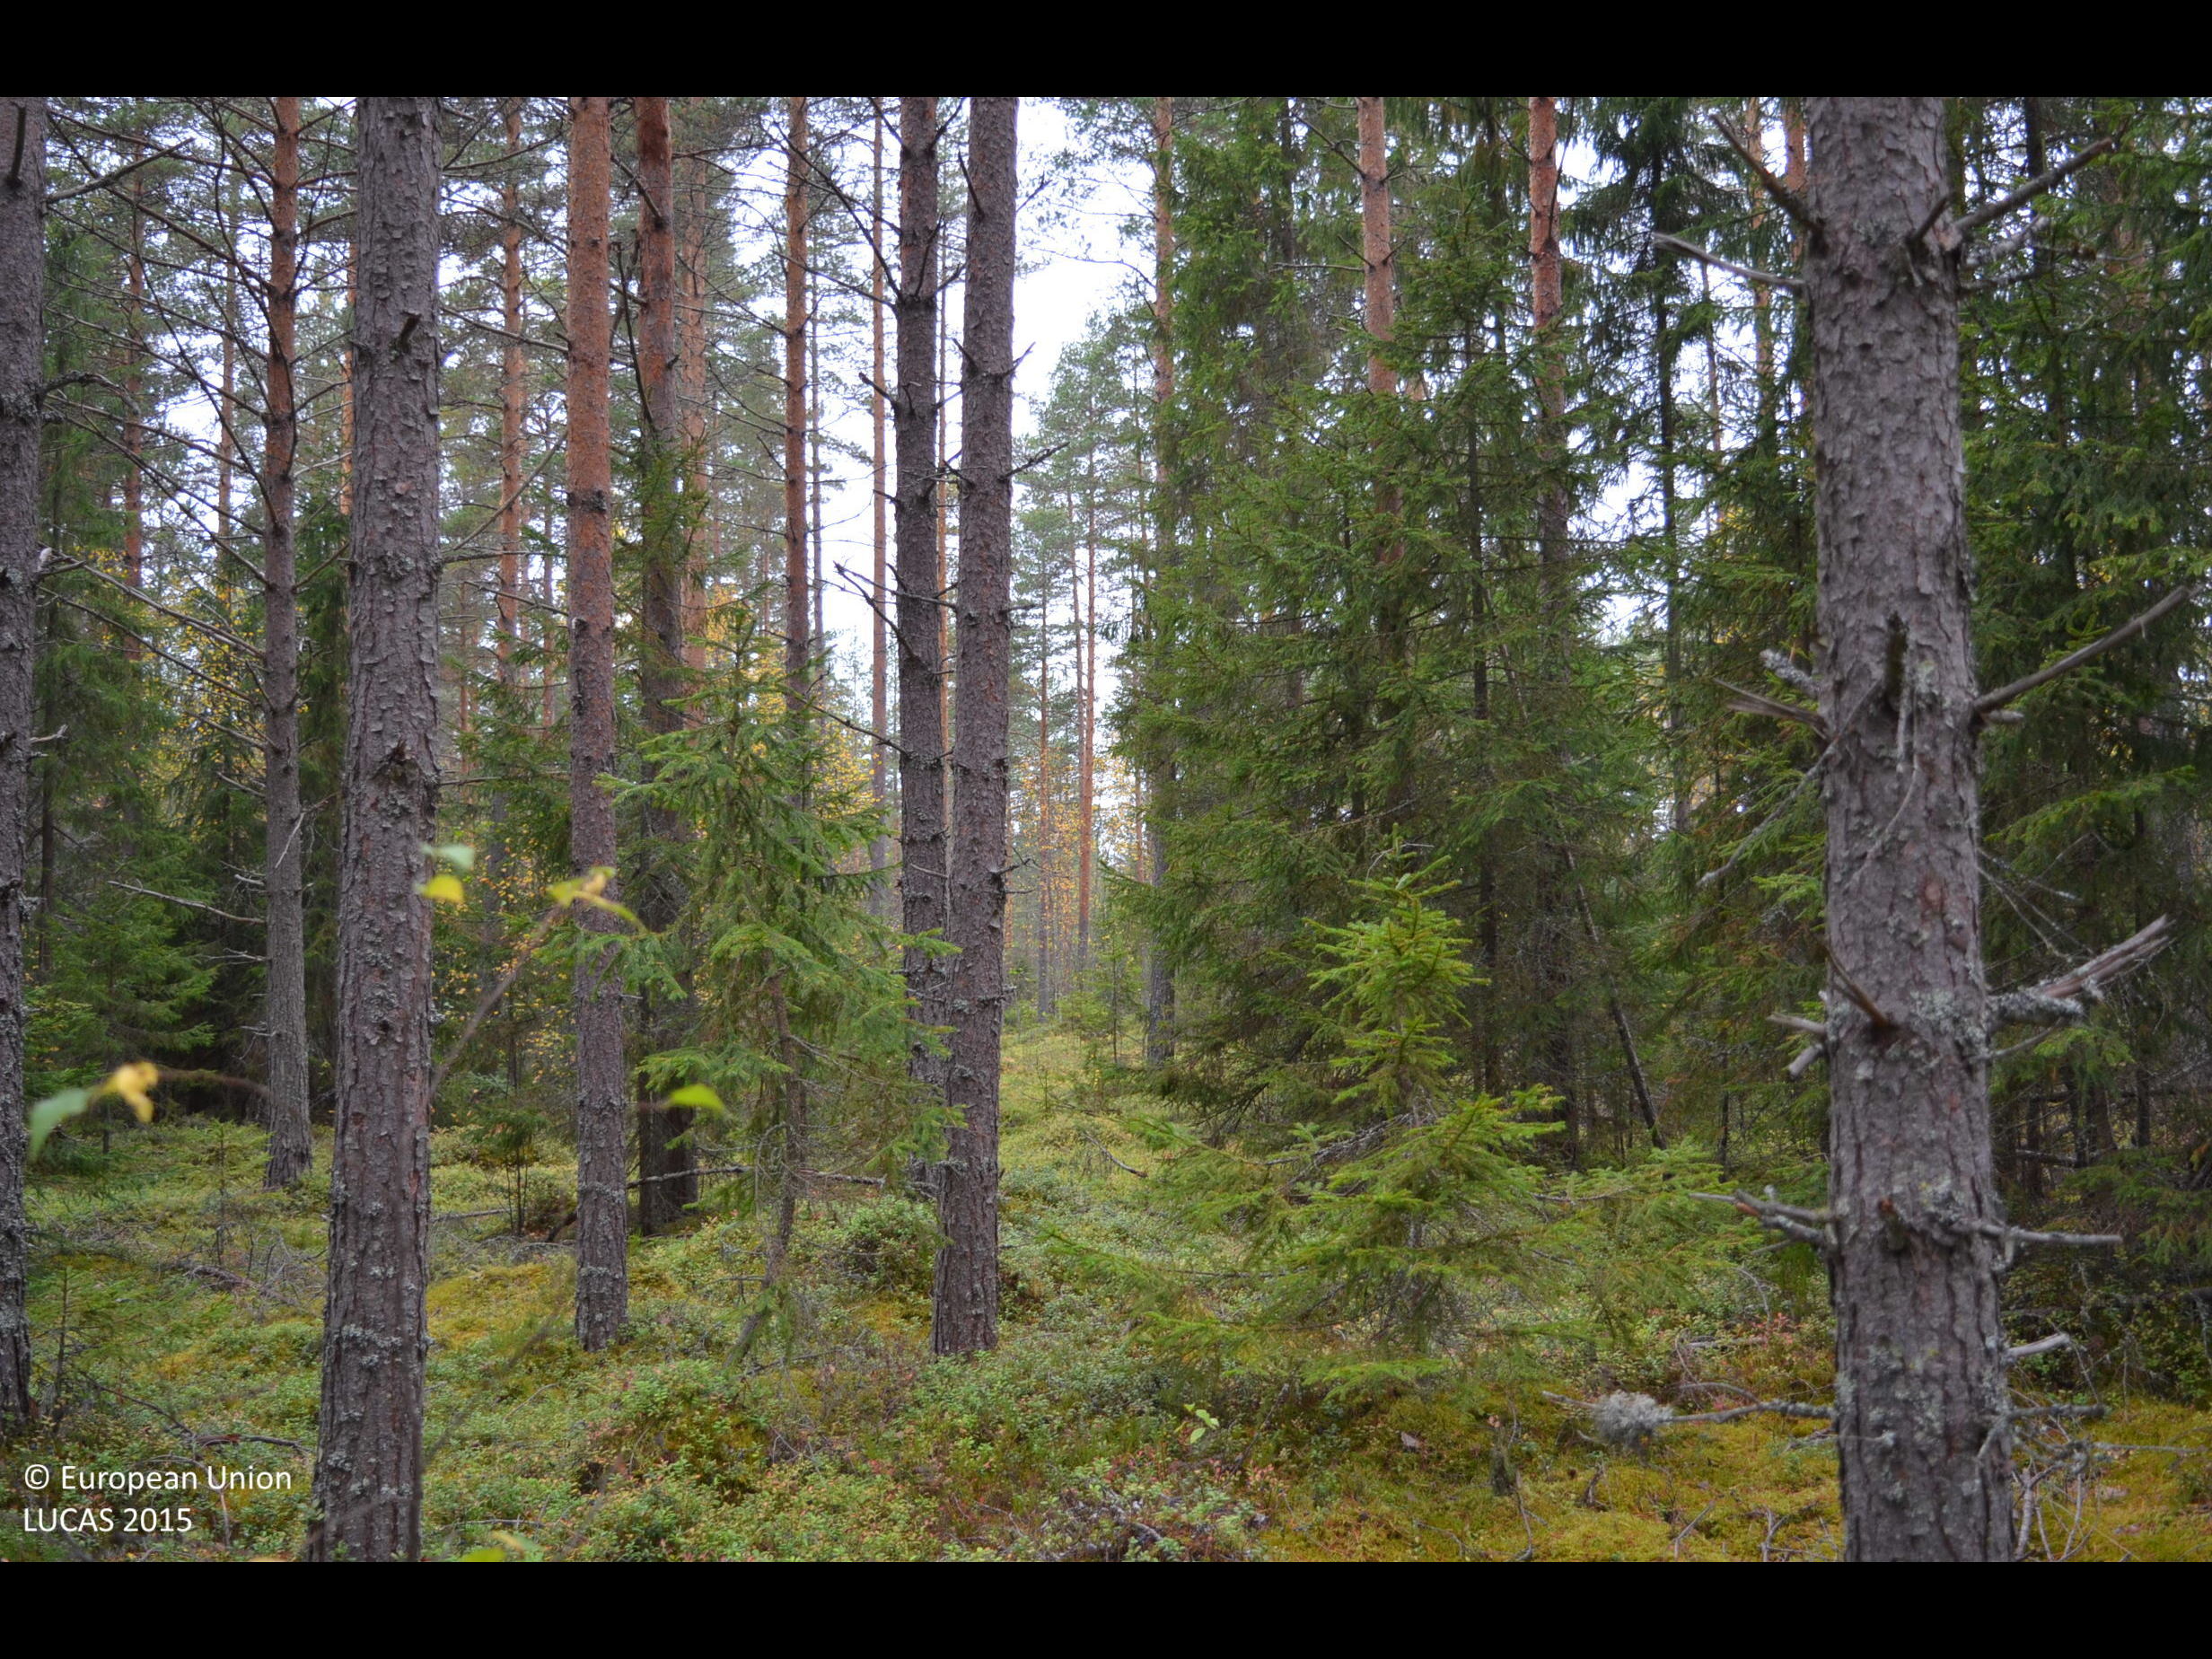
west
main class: Woodland
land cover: Other coniferous woodland
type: boreal forest
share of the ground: 50 - 75 %
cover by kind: coniferous forest trees 70 %, shrubs 20 %, lichens and mosses 10 %
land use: Forestry
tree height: > 5 m
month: September
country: FI
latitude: 62.4978
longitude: 23.6814
